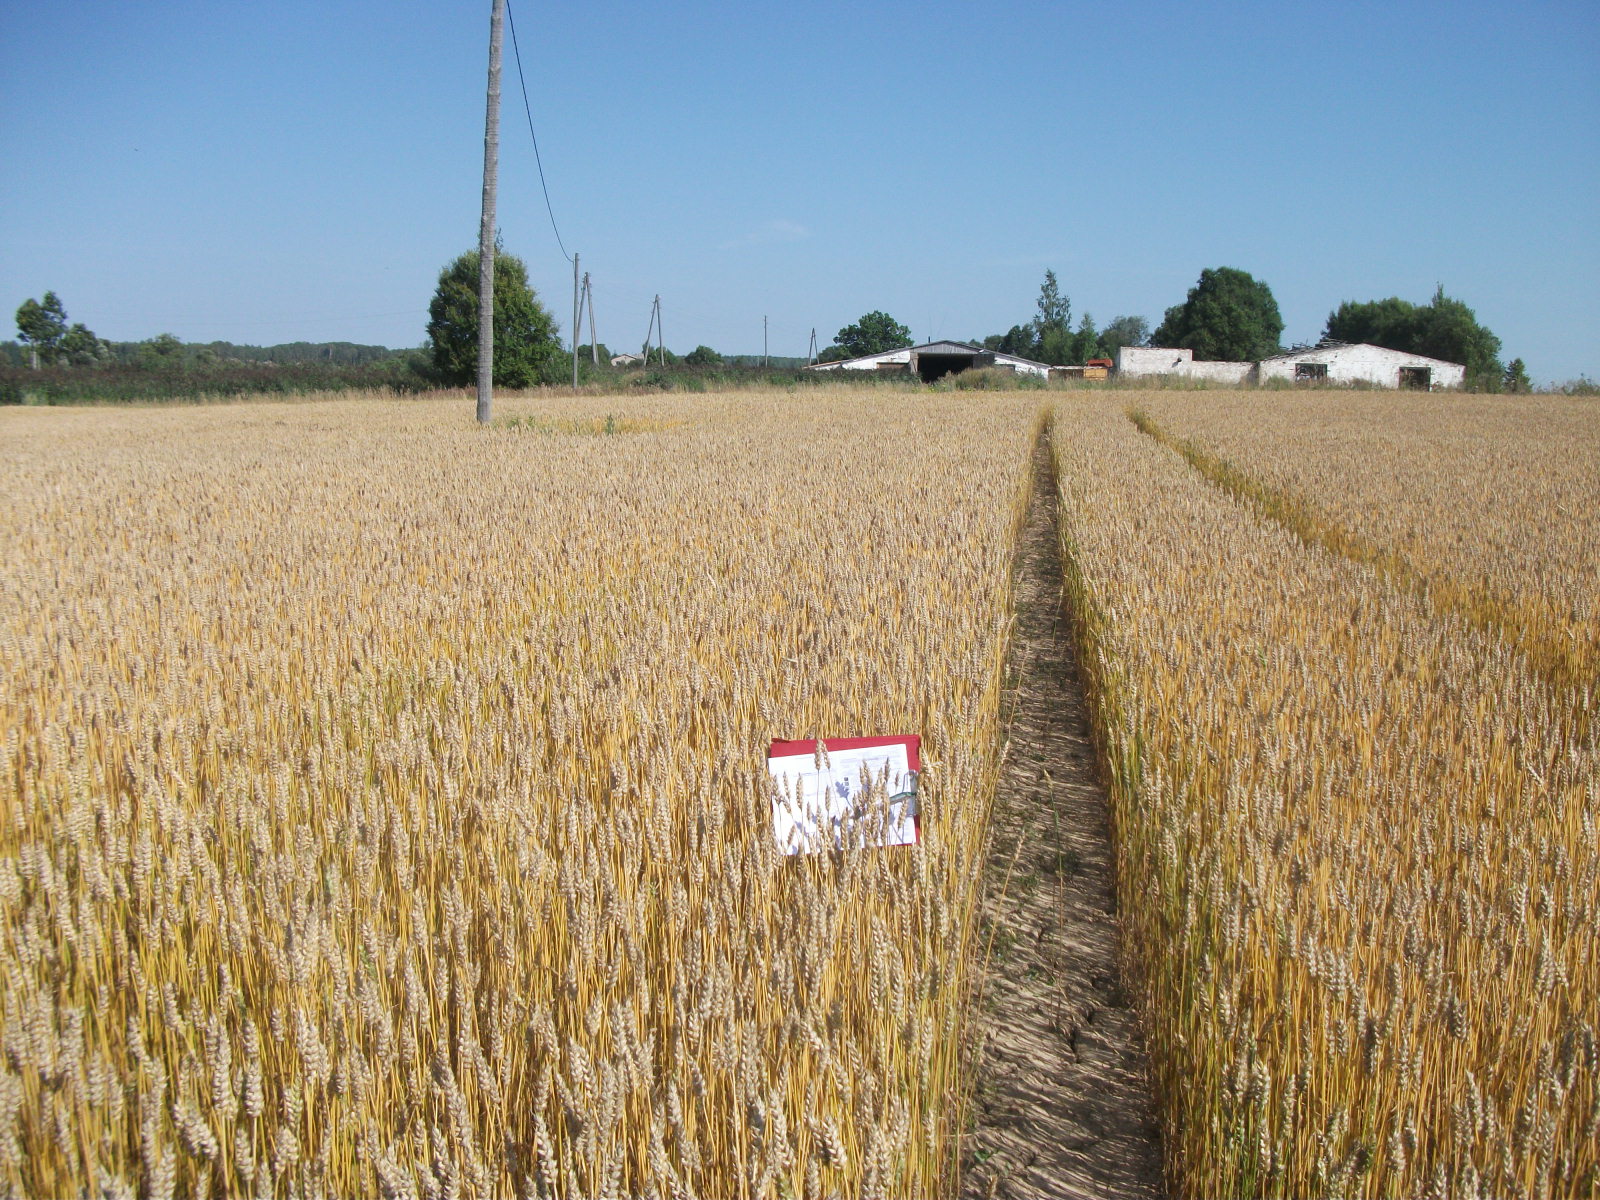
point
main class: Cropland
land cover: Common wheat
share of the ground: > 75 %
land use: Agriculture (excluding fallow land and kitchen gardens)
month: August
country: LV
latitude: 56.6974
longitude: 26.5943
